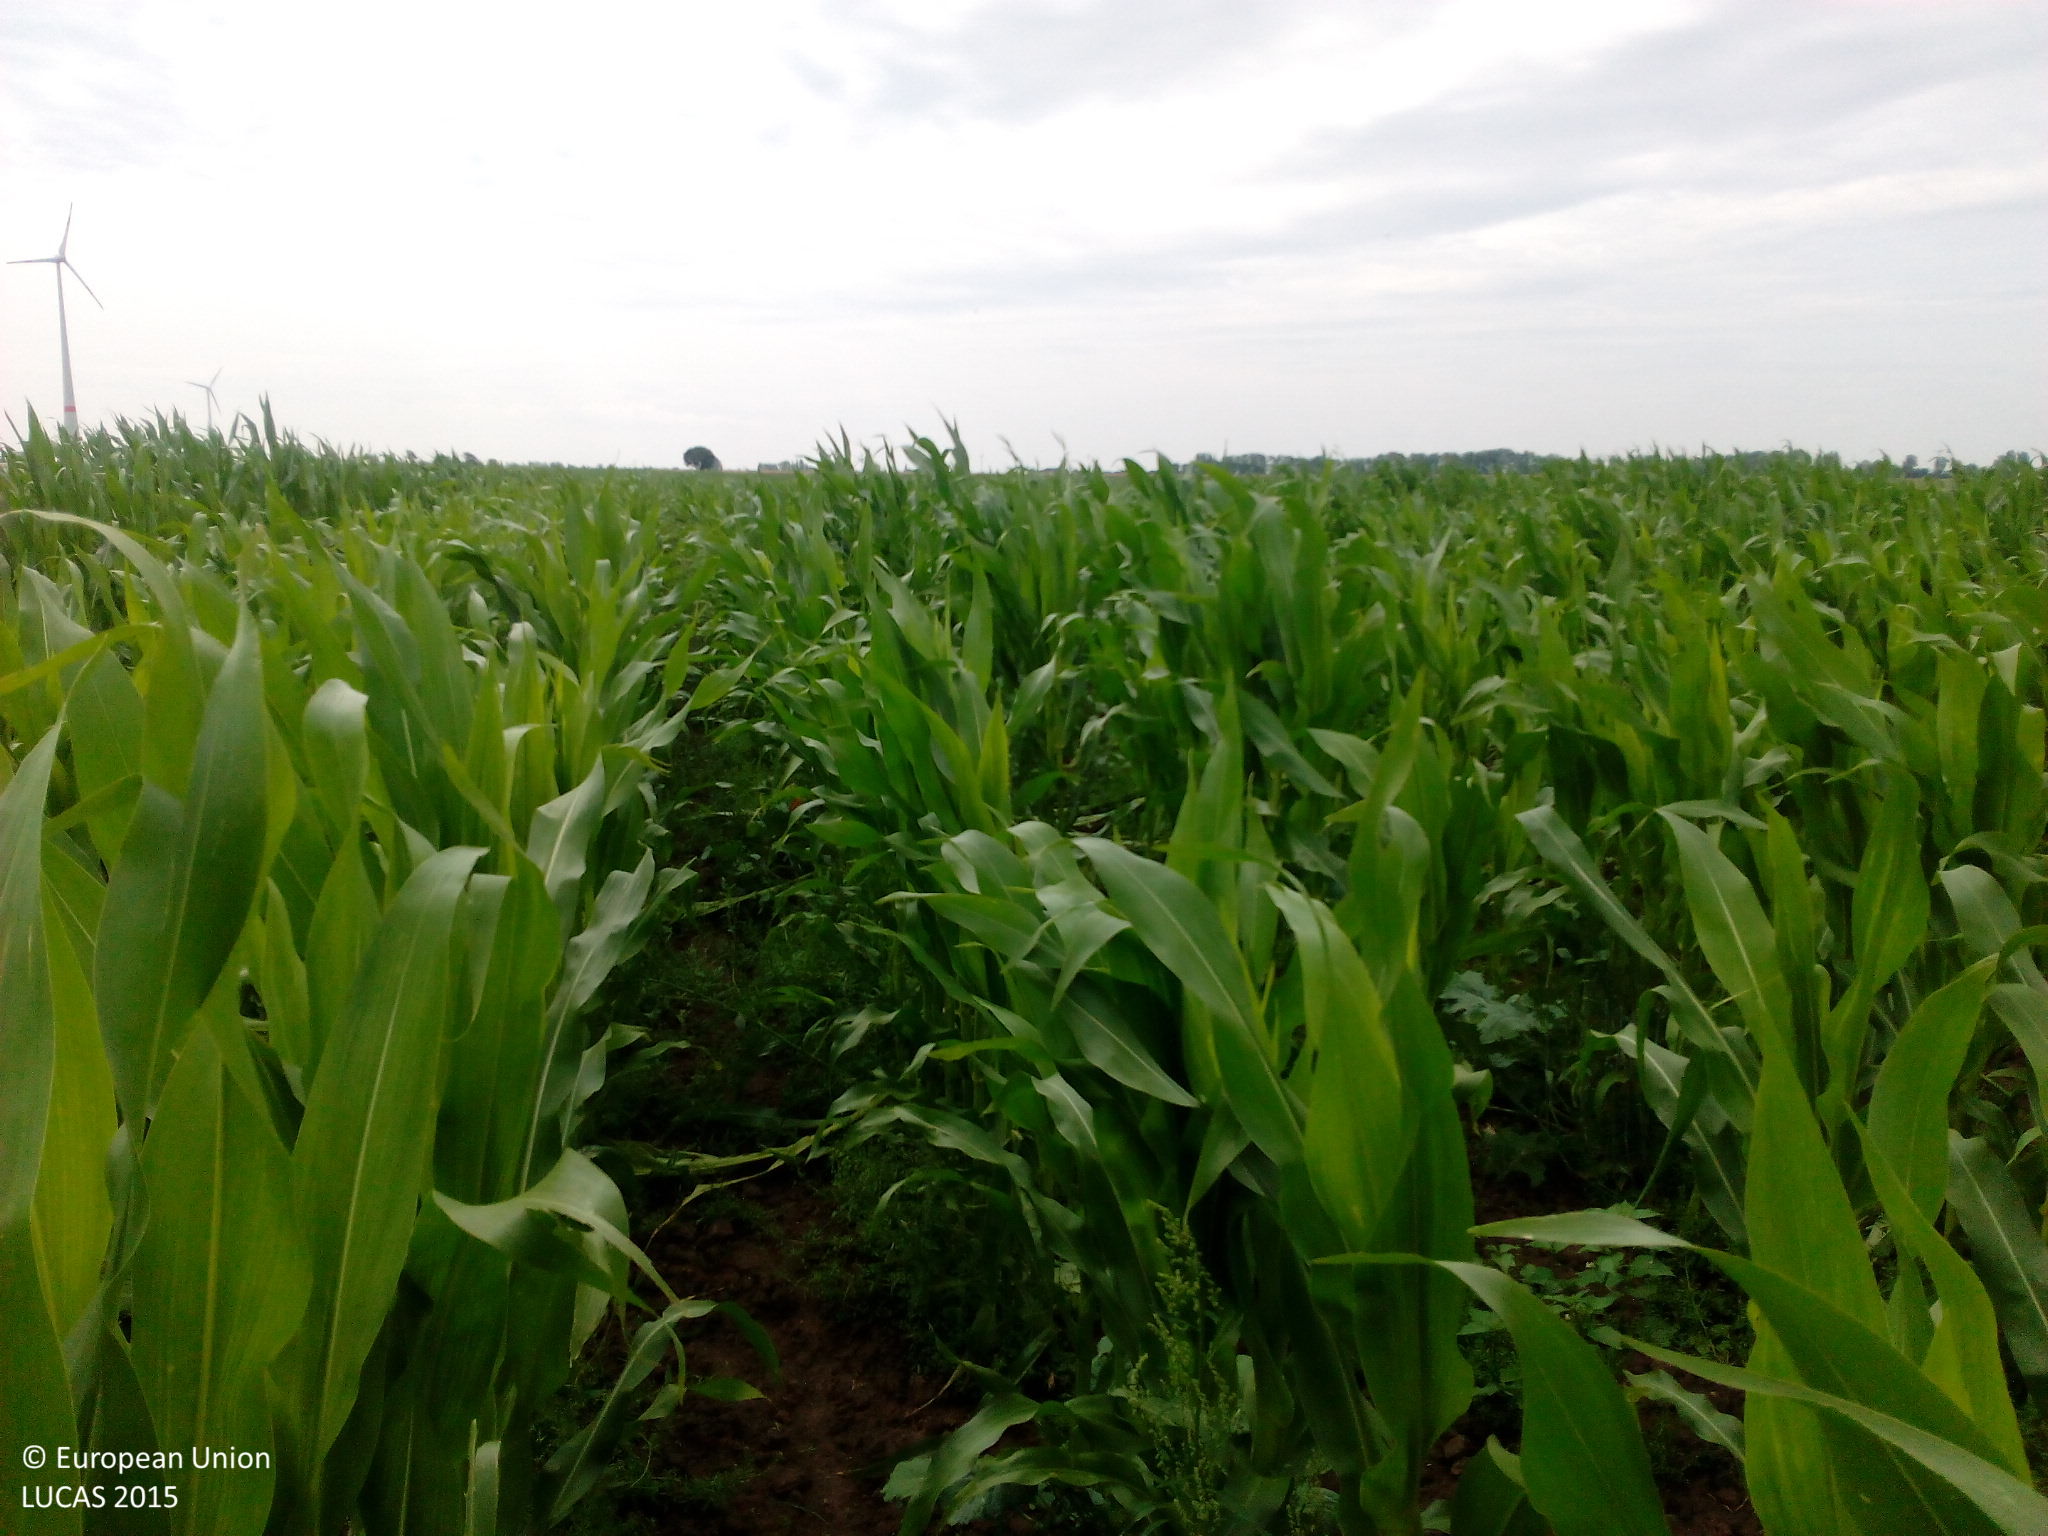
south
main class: Cropland
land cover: Maize
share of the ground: > 75 %
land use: Agriculture (excluding fallow land and kitchen gardens)
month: July
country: DE
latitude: 51.9718
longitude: 11.5572
